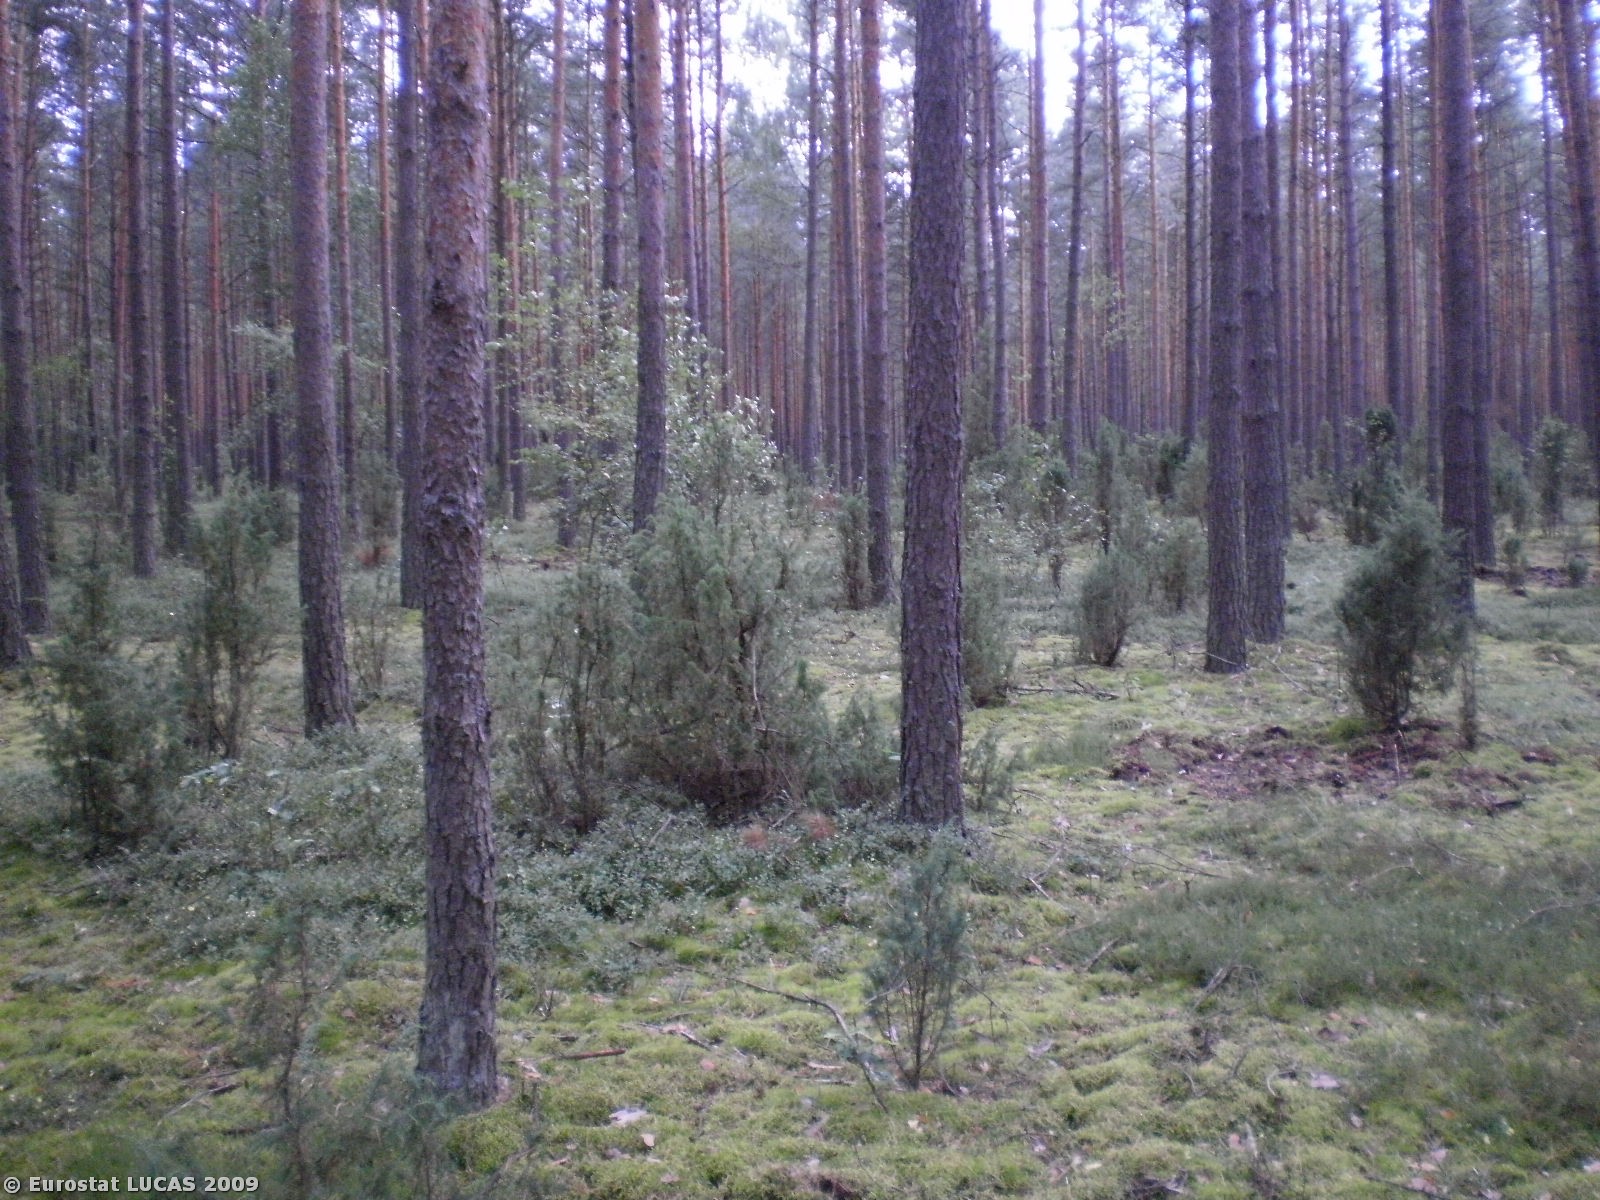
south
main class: Woodland
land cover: Coniferous woodland
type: hemiboreal forest and nemoral coniferous forest and mixed broadleaved-coniferous forest
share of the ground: > 75 %
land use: Forestry
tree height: > 5 m
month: August
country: PL
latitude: 52.7611
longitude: 21.6862
